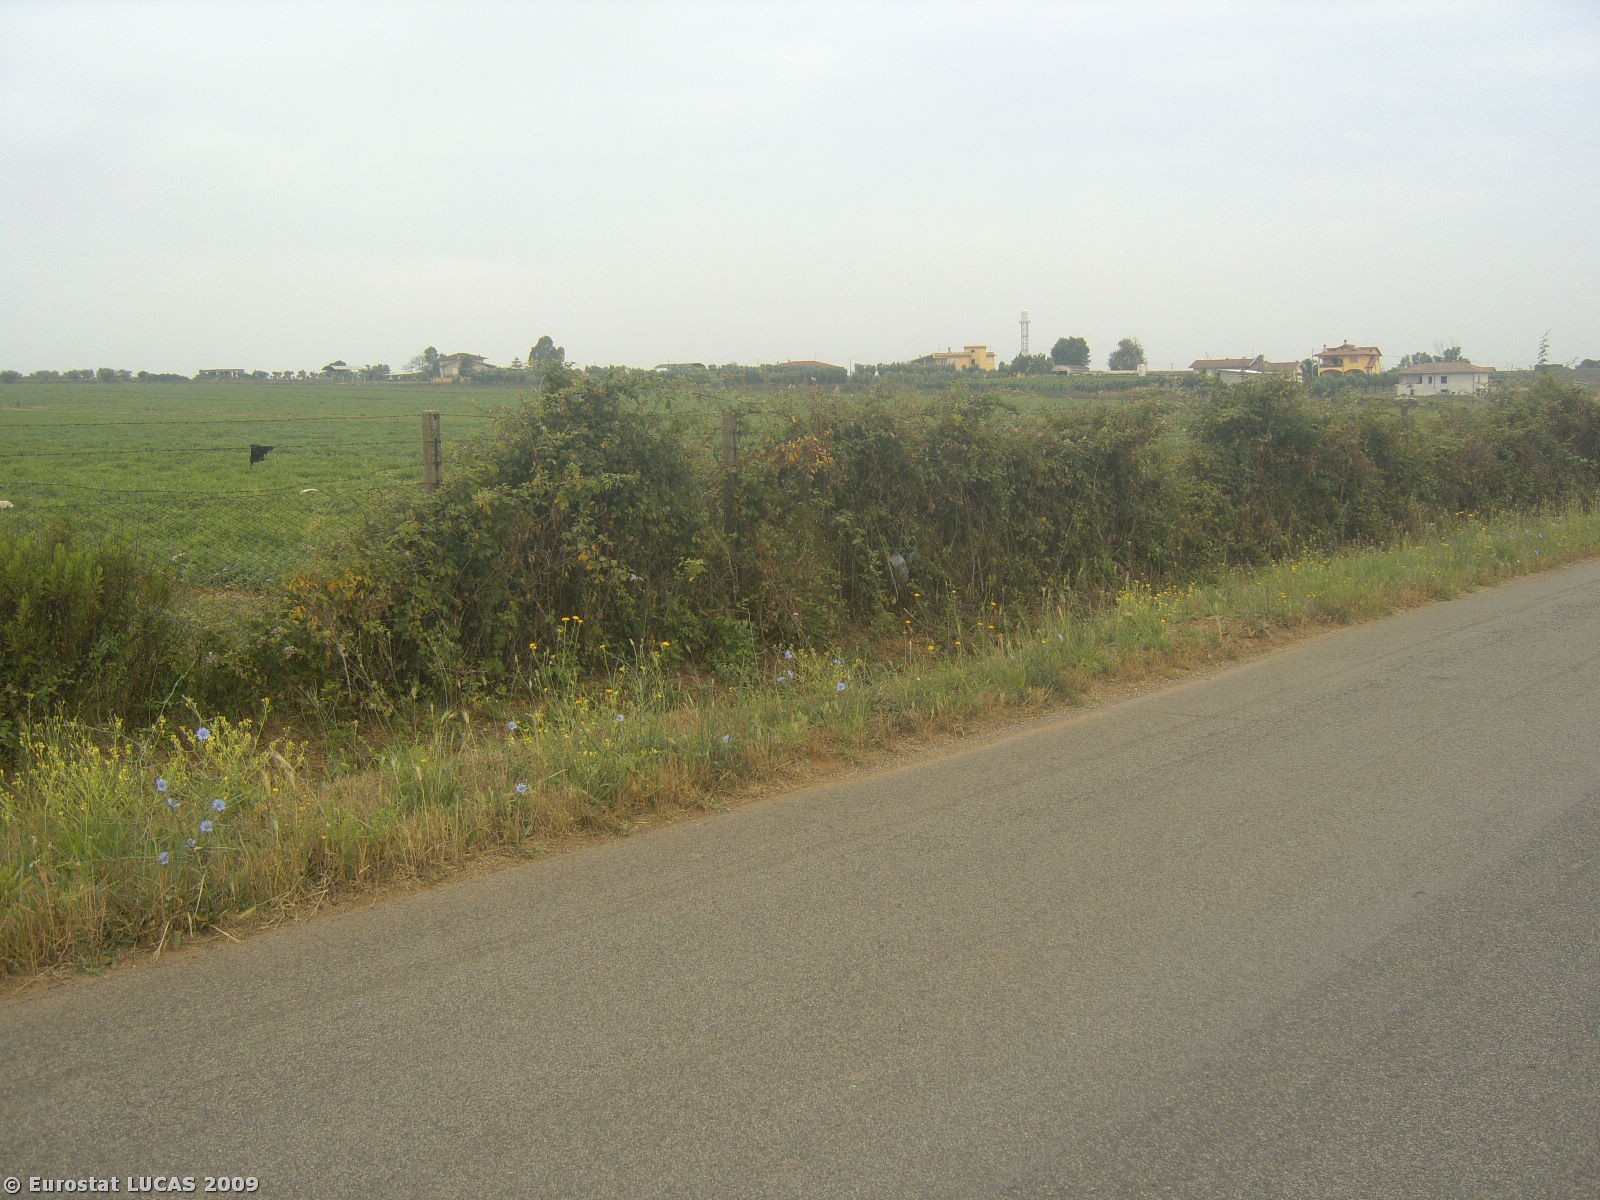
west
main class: Cropland
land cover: Vineyards
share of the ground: 50 - 75 %
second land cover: Bare land
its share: 10 - 25 %
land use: Agriculture (excluding fallow land and kitchen gardens)
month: June
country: IT
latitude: 41.5143
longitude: 12.7330
